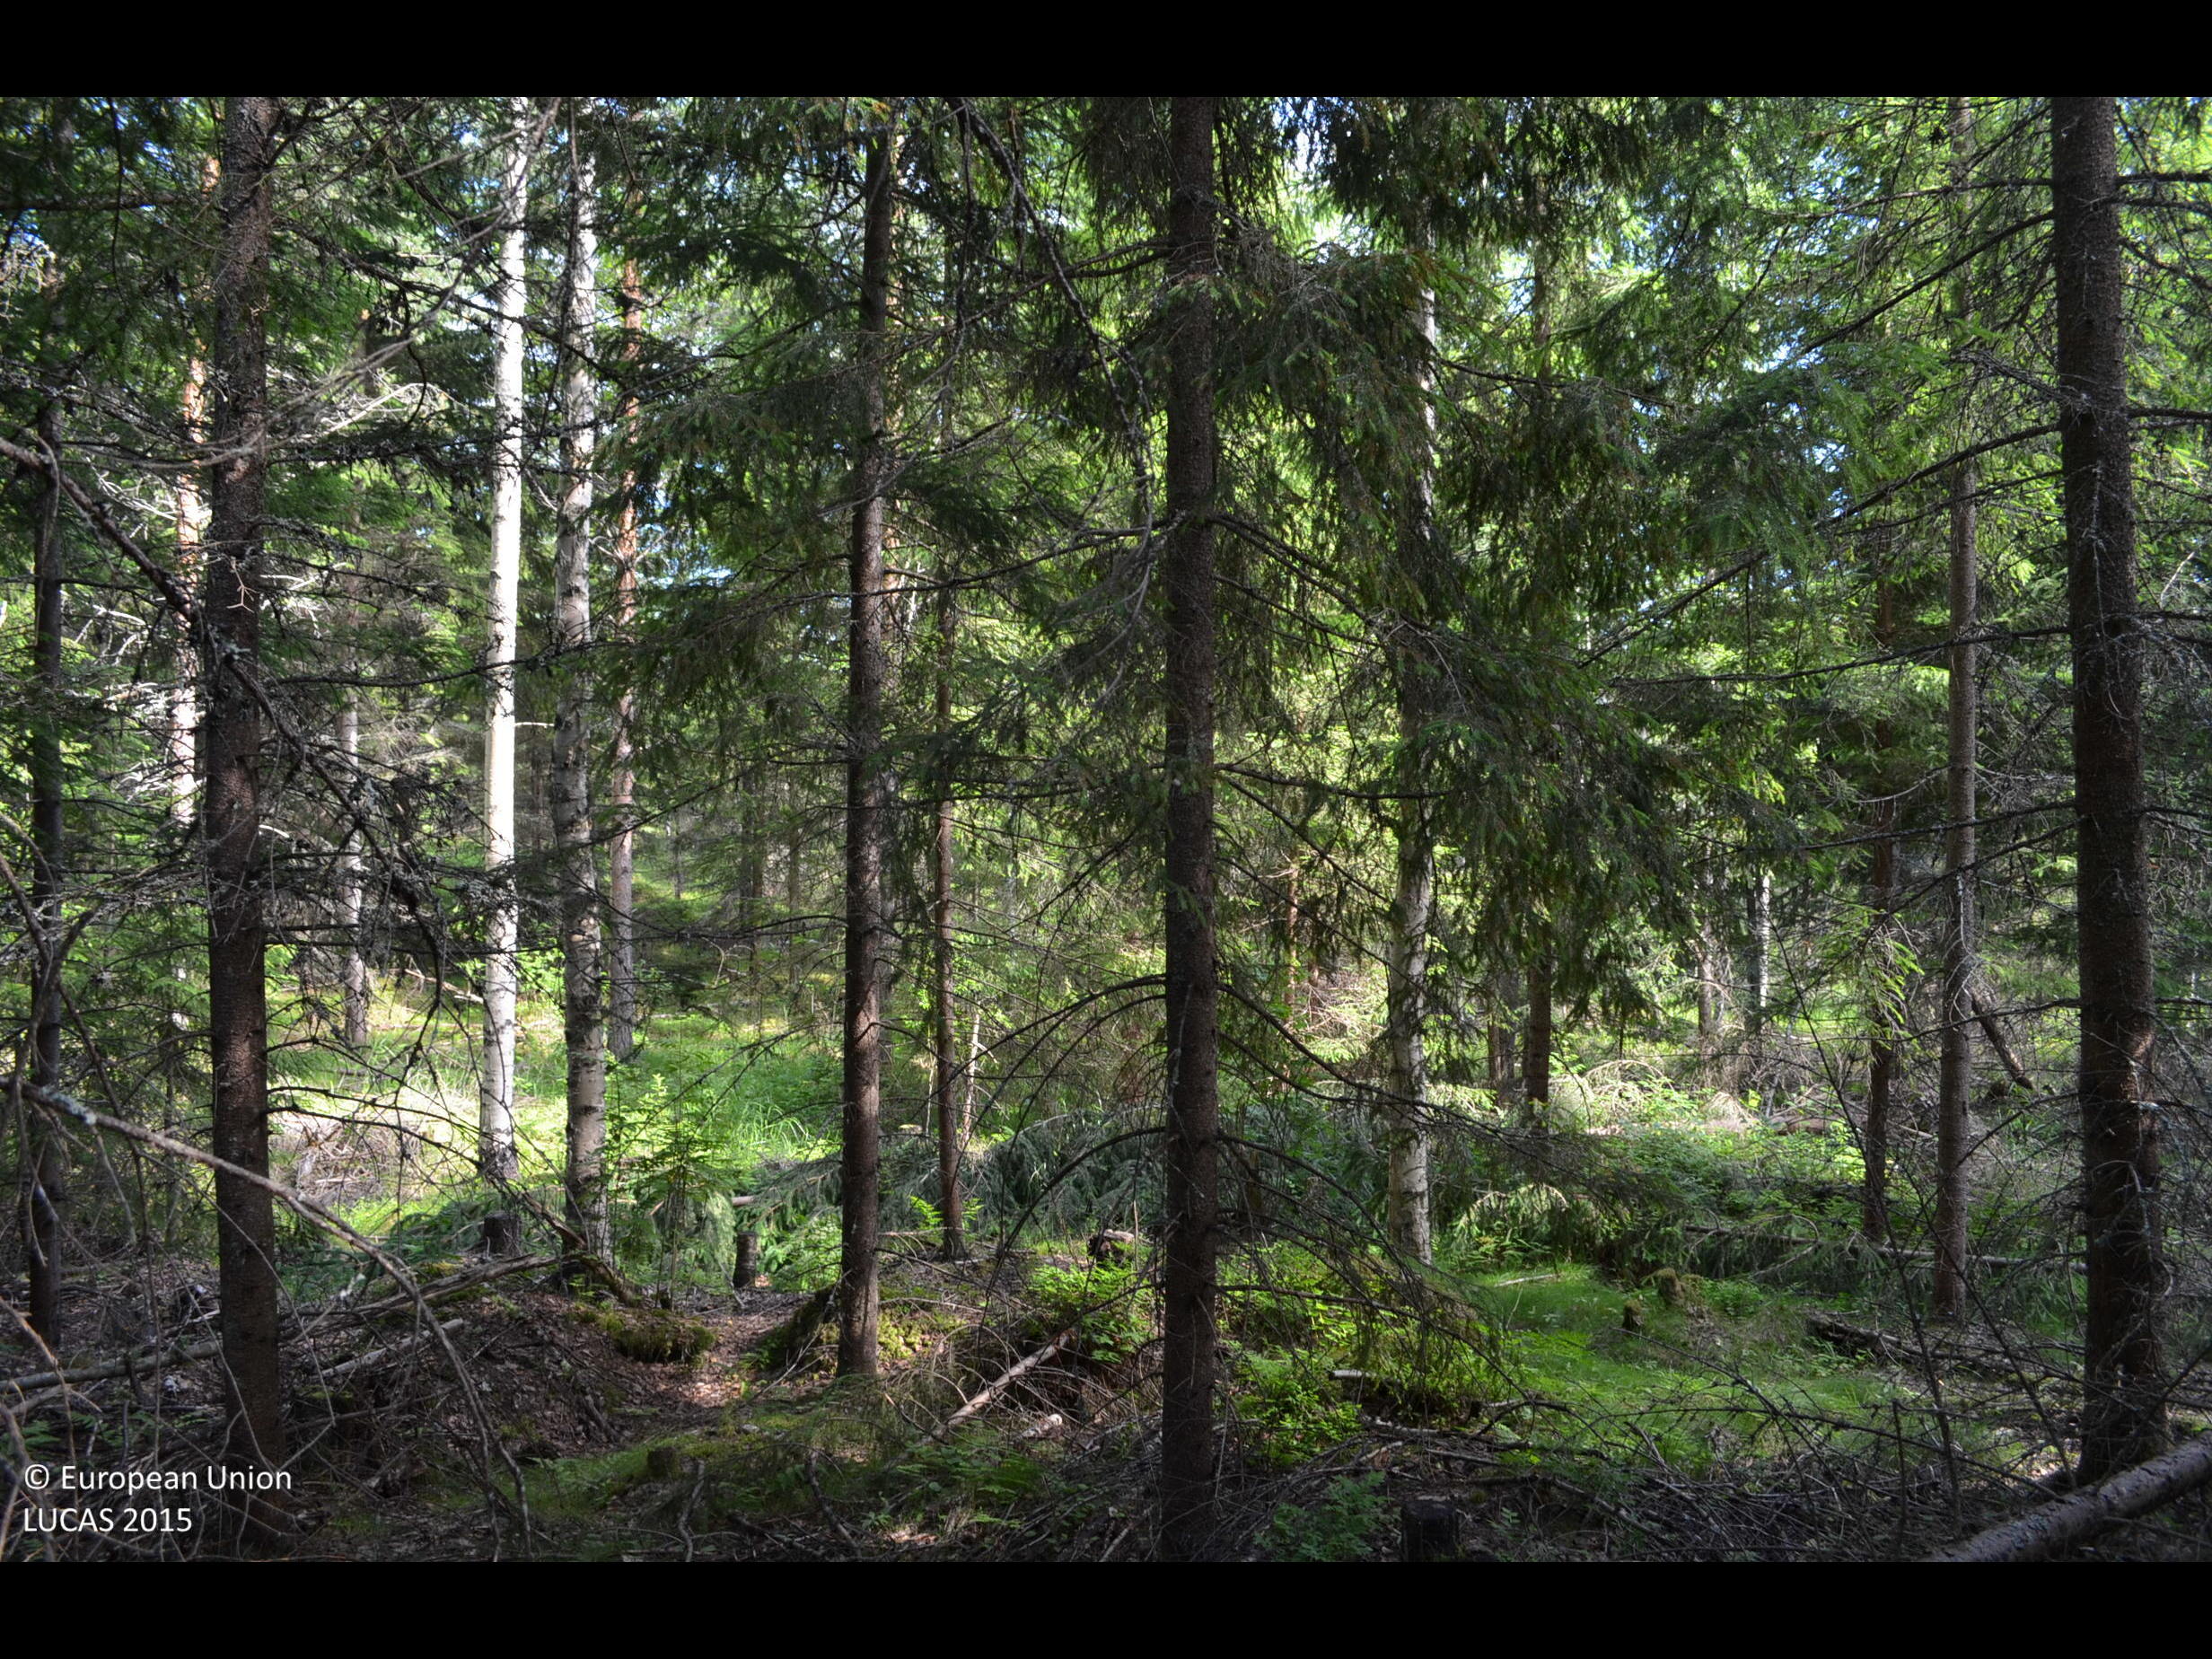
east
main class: Woodland
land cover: Spruce dominated mixed woodland
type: boreal forest
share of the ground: > 75 %
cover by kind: coniferous forest trees 55 %, broadleaved forest trees 20 %, shrubs 10 %, herbaceous plants 5 %, lichens and mosses 5 %
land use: Forestry
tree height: > 5 m
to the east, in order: Spruce dominated mixed woodland; Other mixed woodland; Ditches and canals; Pine dominated coniferous woodland
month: July
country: FI
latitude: 61.8388
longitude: 23.4665
